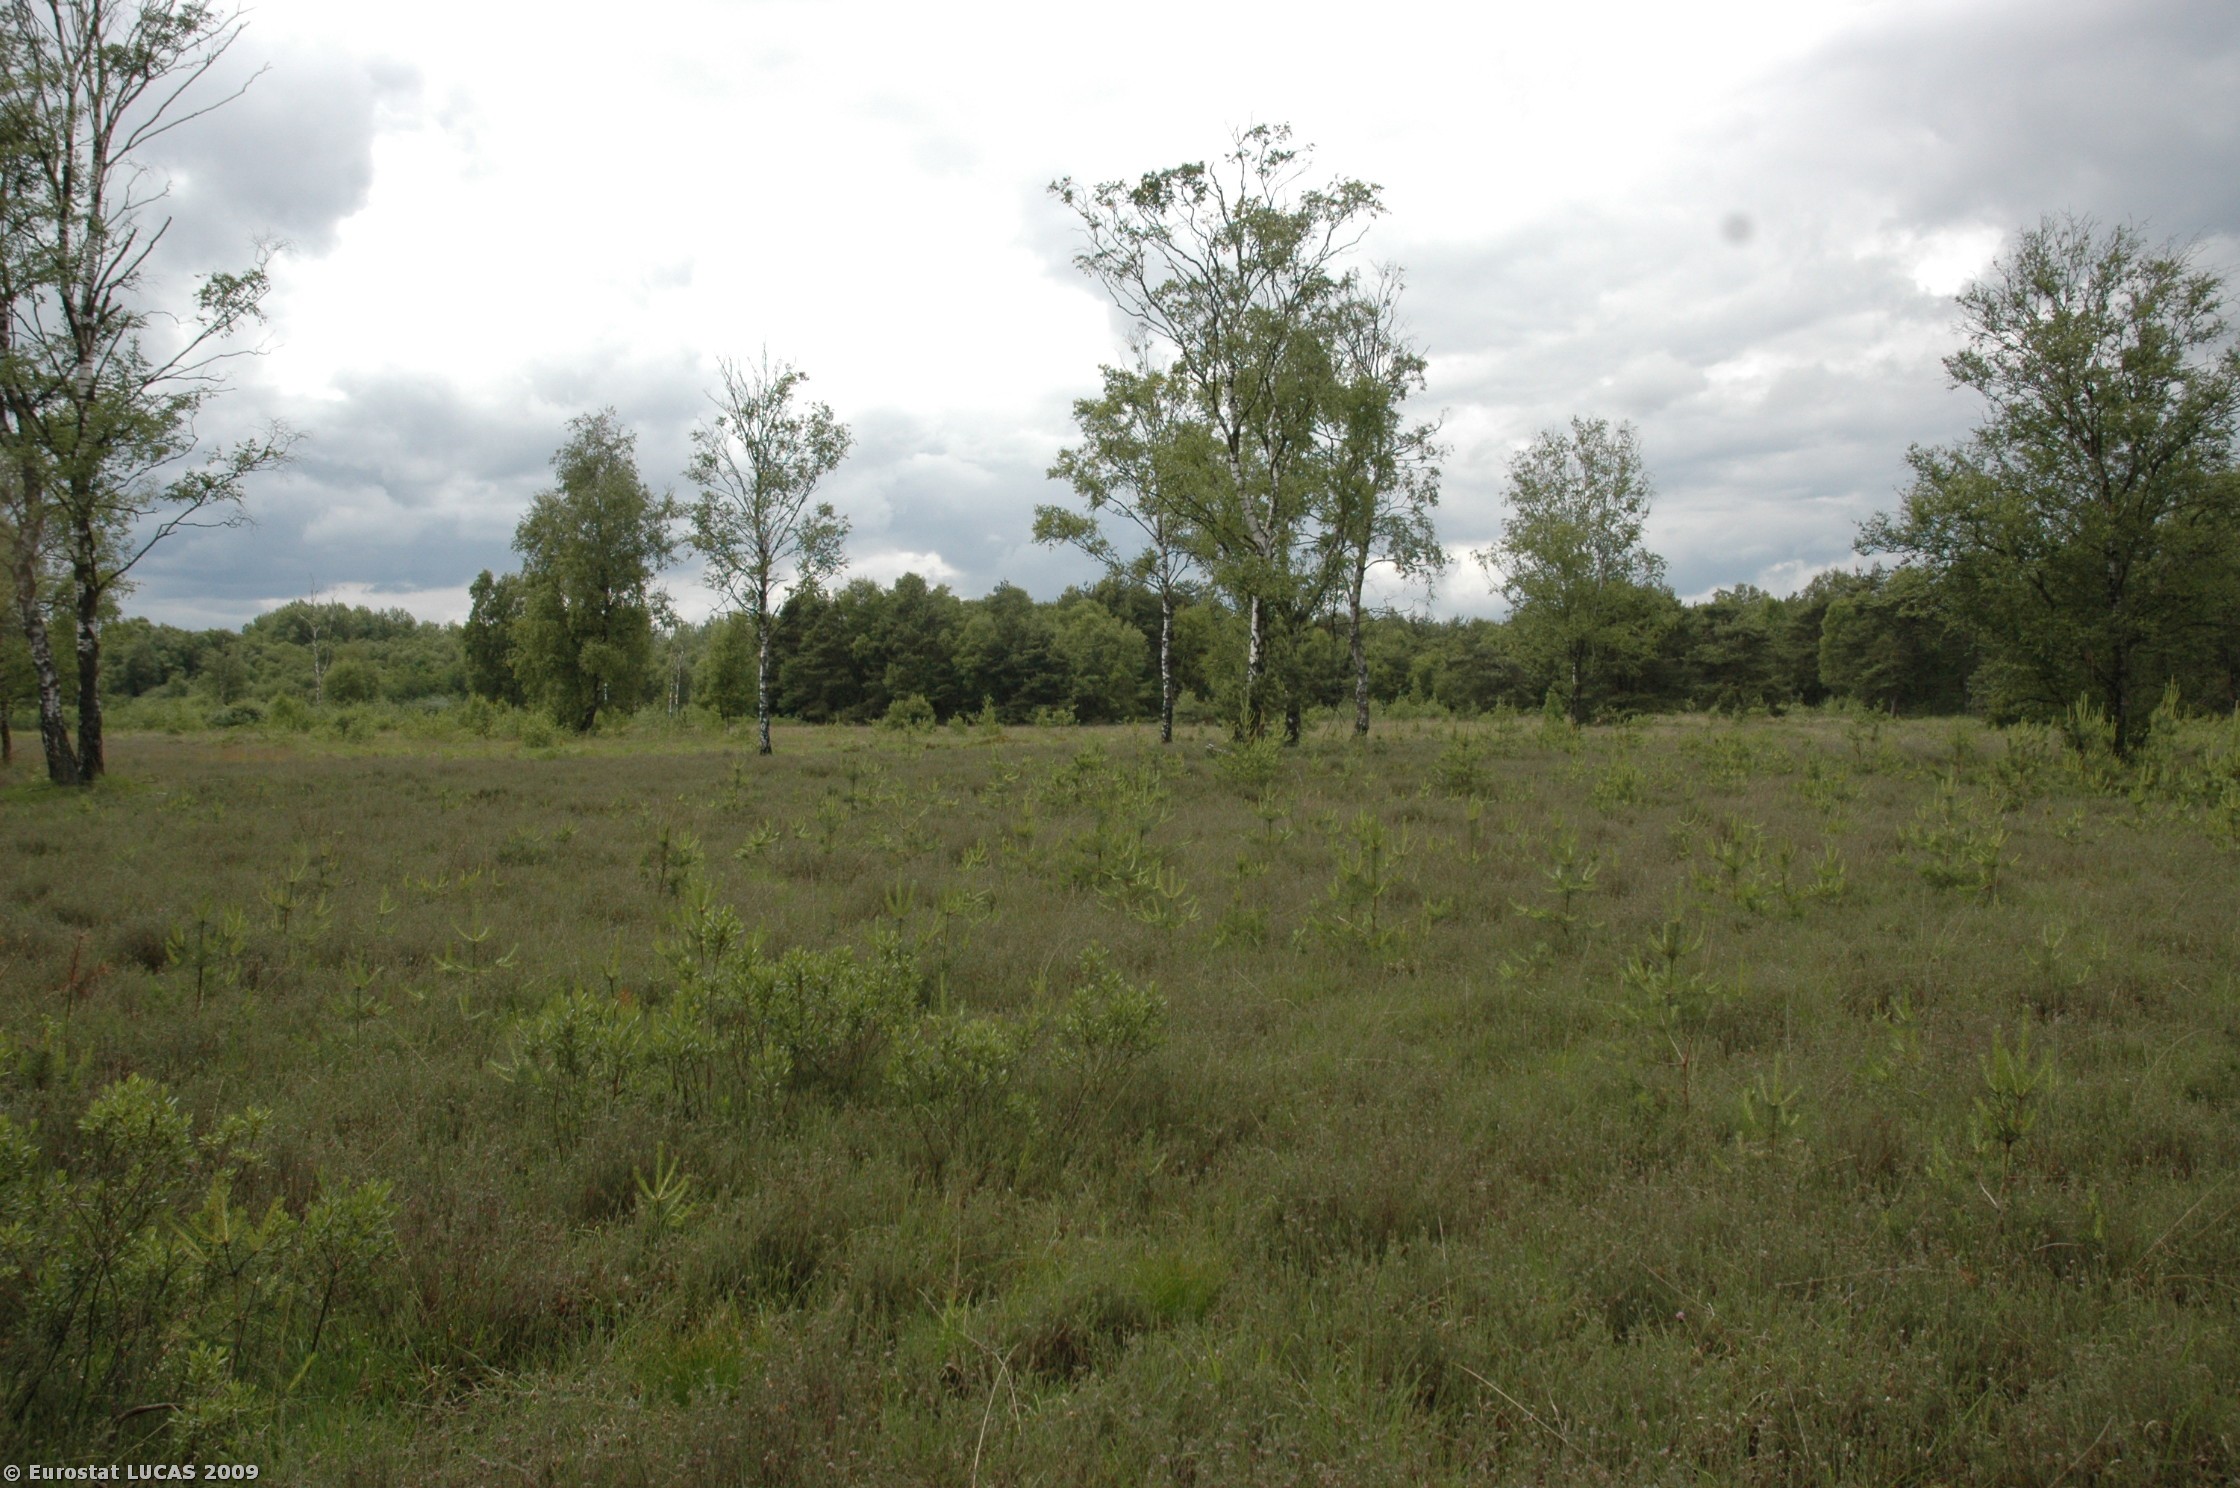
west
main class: Shrubland
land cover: Shrubland without tree cover
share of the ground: > 75 %
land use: Nature reserves
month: June
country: NL
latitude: 52.1335
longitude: 6.0985
